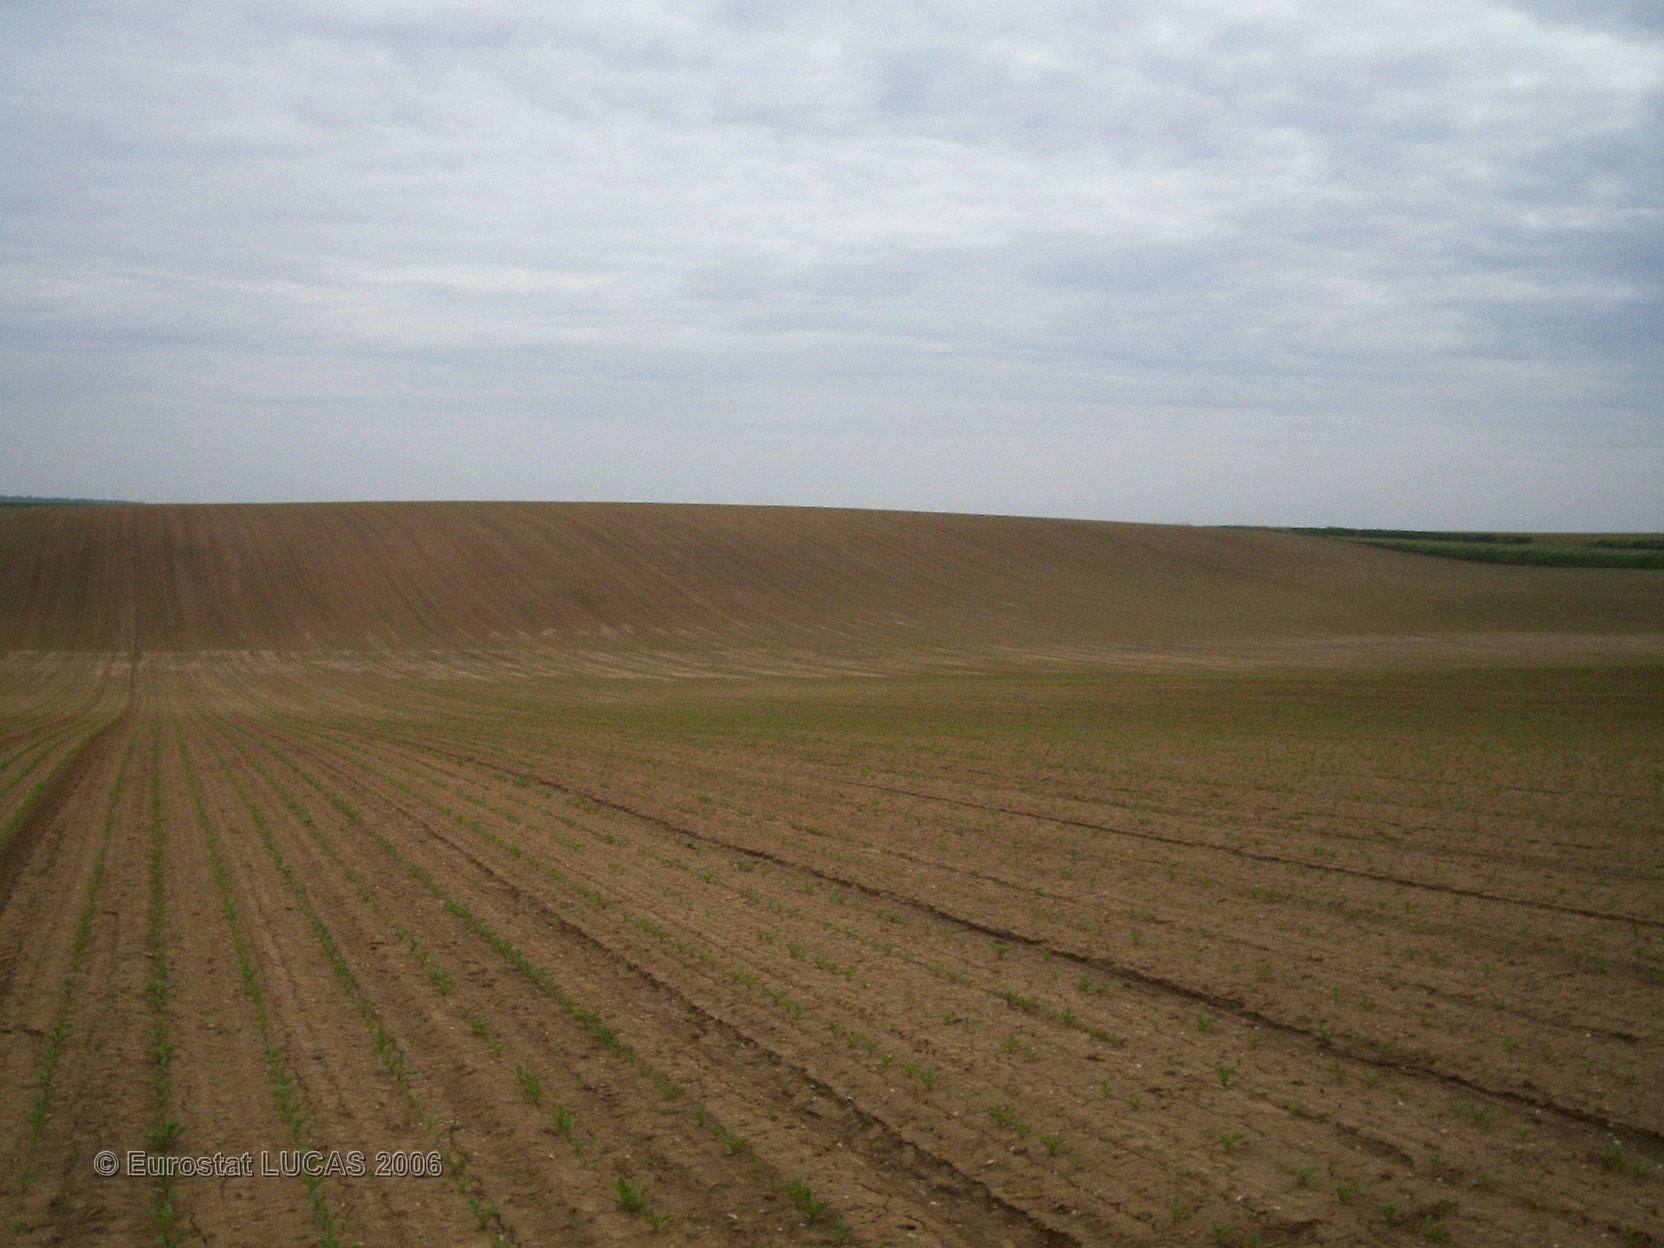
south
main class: Cropland
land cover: Sugar beet
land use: Agriculture (excluding fallow land and kitchen gardens)
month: May
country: FR
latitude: 49.8621
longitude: 3.6357
